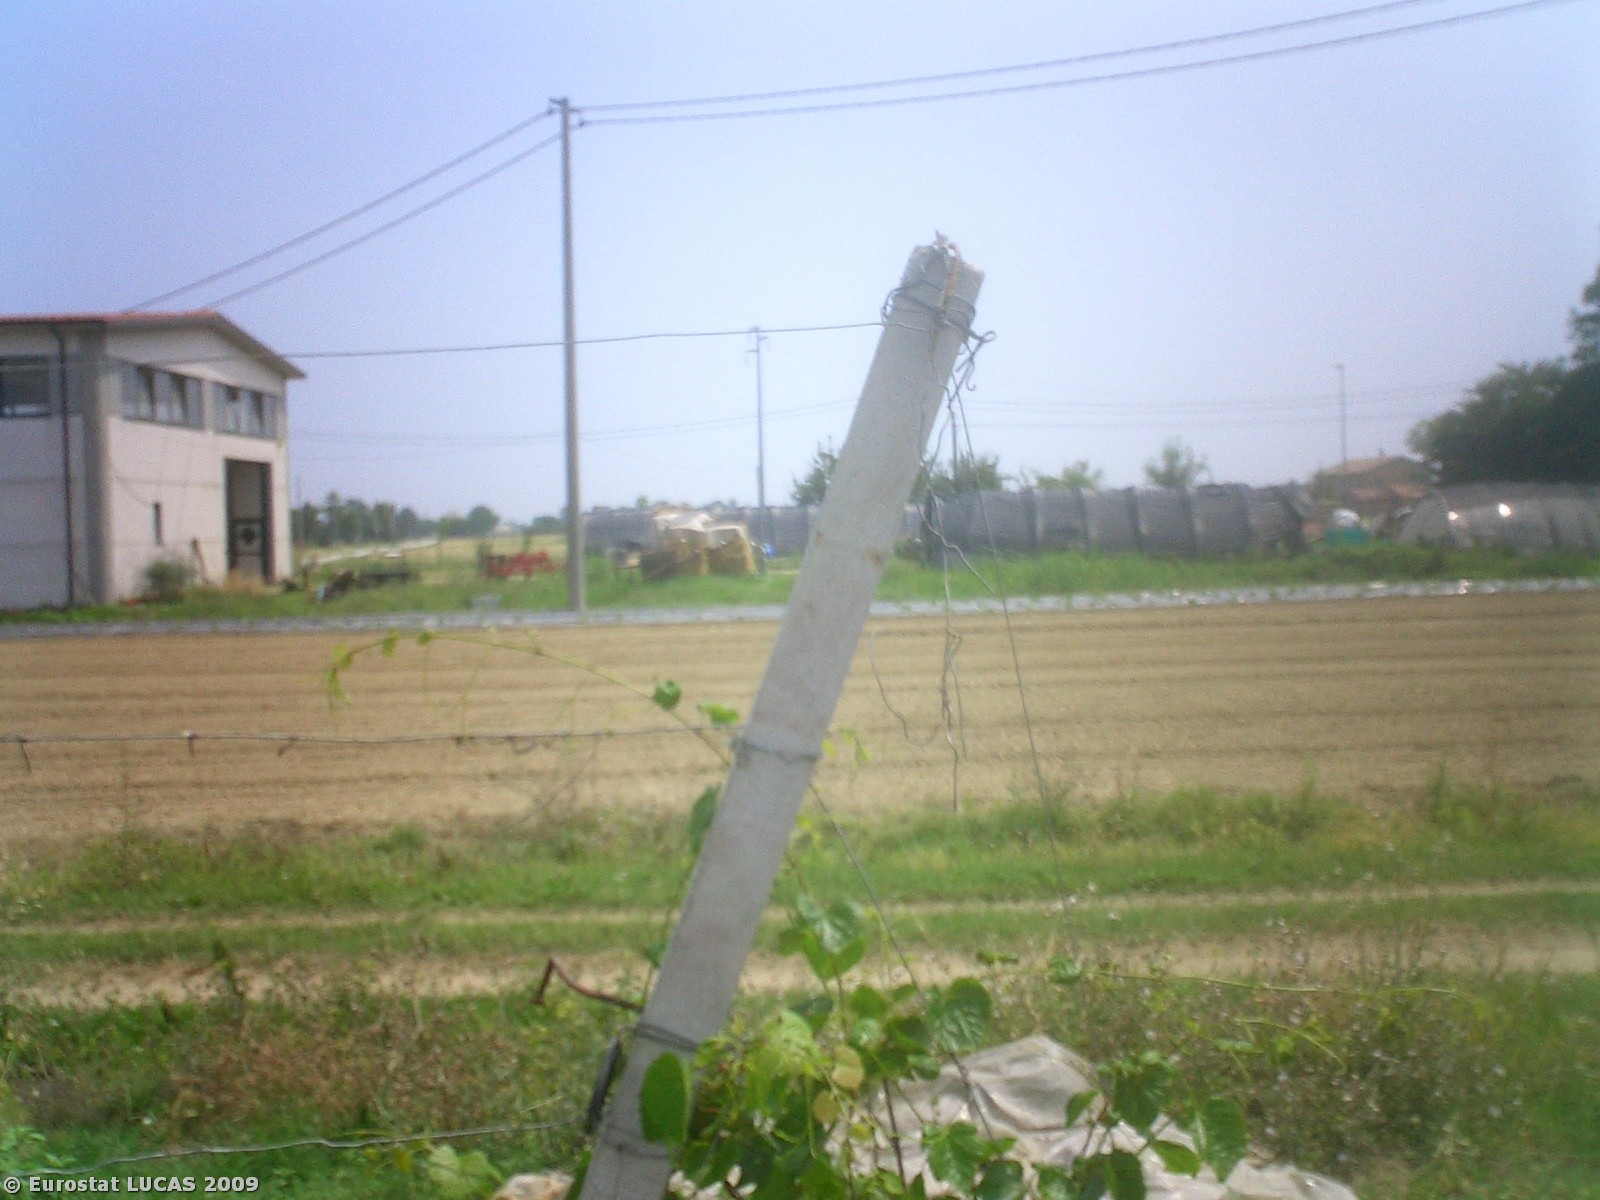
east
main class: Cropland
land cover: Vineyards
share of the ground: 50 - 75 %
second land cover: Grassland with sparse tree/shrub cover
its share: 50 - 75 %
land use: Agriculture (excluding fallow land and kitchen gardens)
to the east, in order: Vineyards; Grassland with sparse tree/shrub cover; Ditches and canals; Tracks; Ditches and canals; Bare land; Artificial constructions in urban areas; Ditches and canals; Paved roads, cycling and walking lanes; Ditches and canals; Lucerne; Electric lines; Lucerne
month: July
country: IT
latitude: 44.1428
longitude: 12.3823
